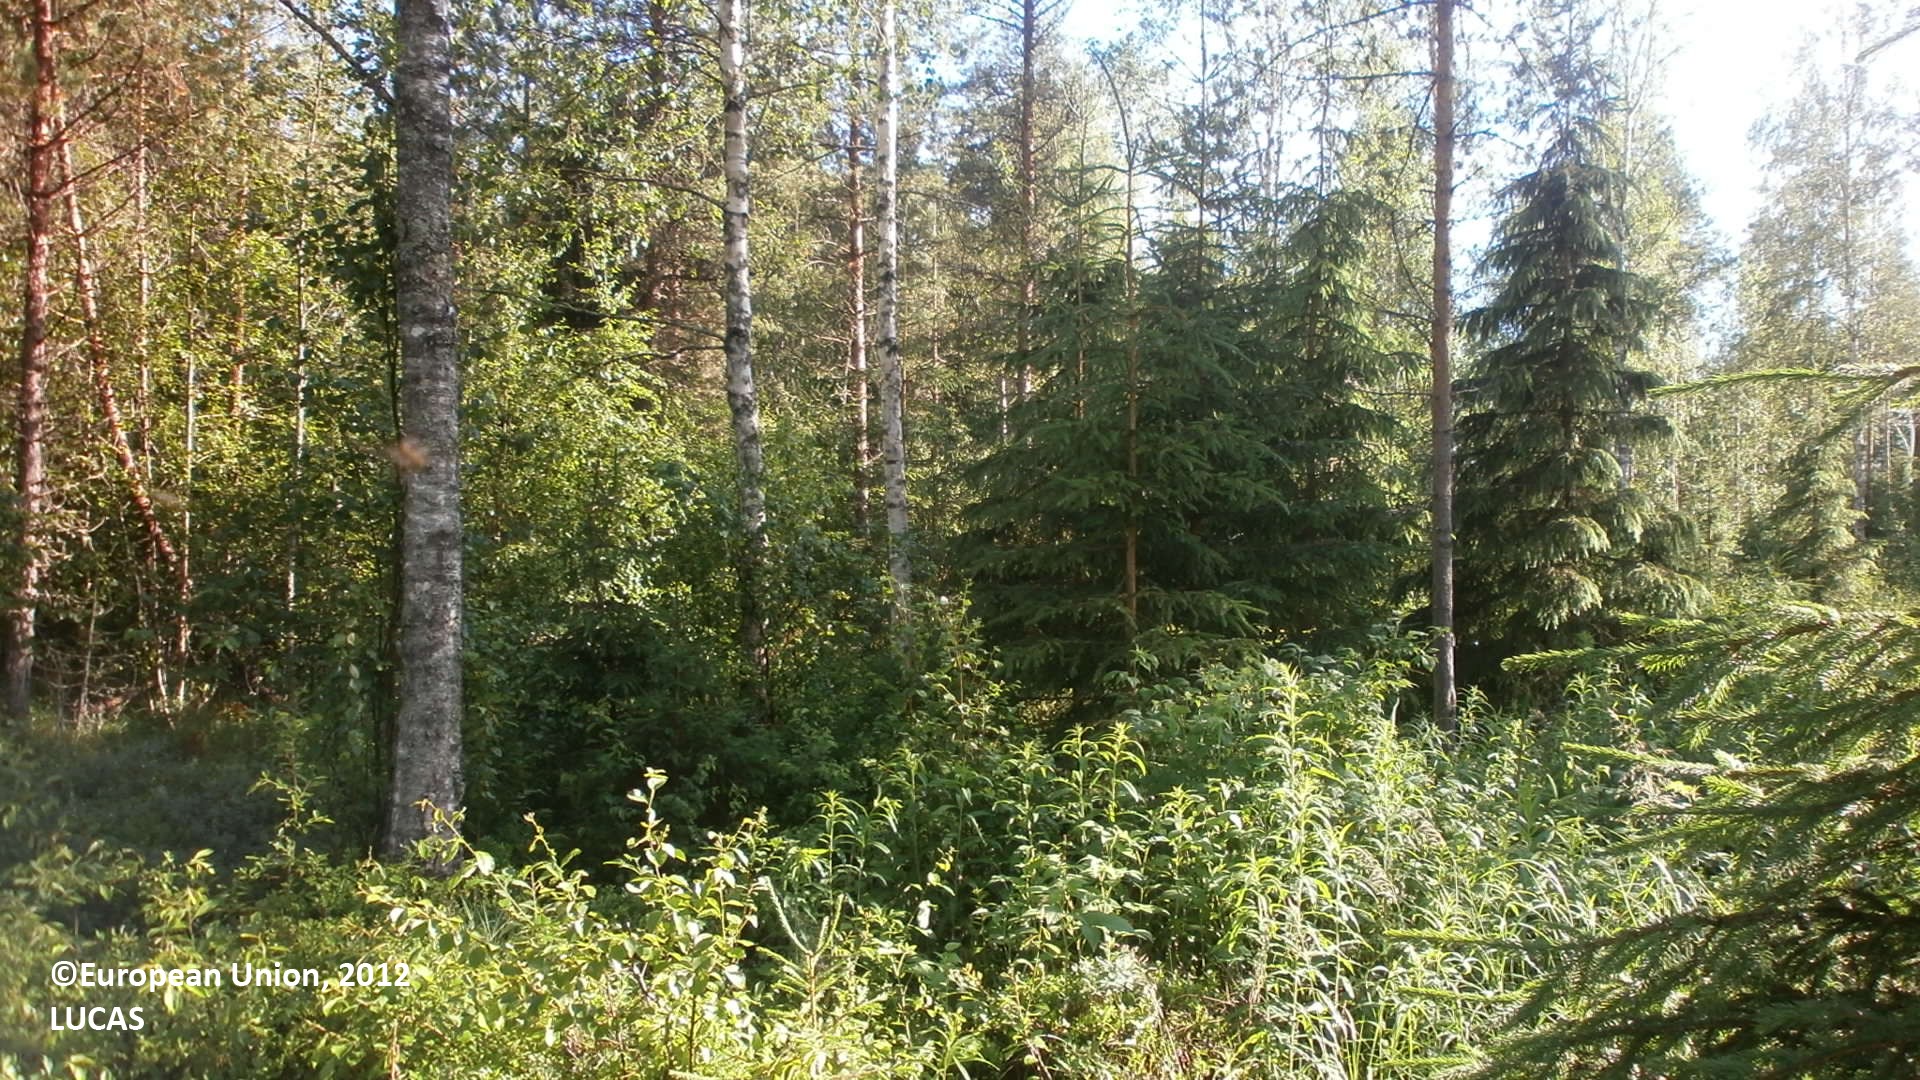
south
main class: Woodland
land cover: Pine dominated mixed woodland
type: boreal forest
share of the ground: 50 - 75 %
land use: Forestry
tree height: > 5 m
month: July
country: FI
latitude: 64.4425
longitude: 24.3391
